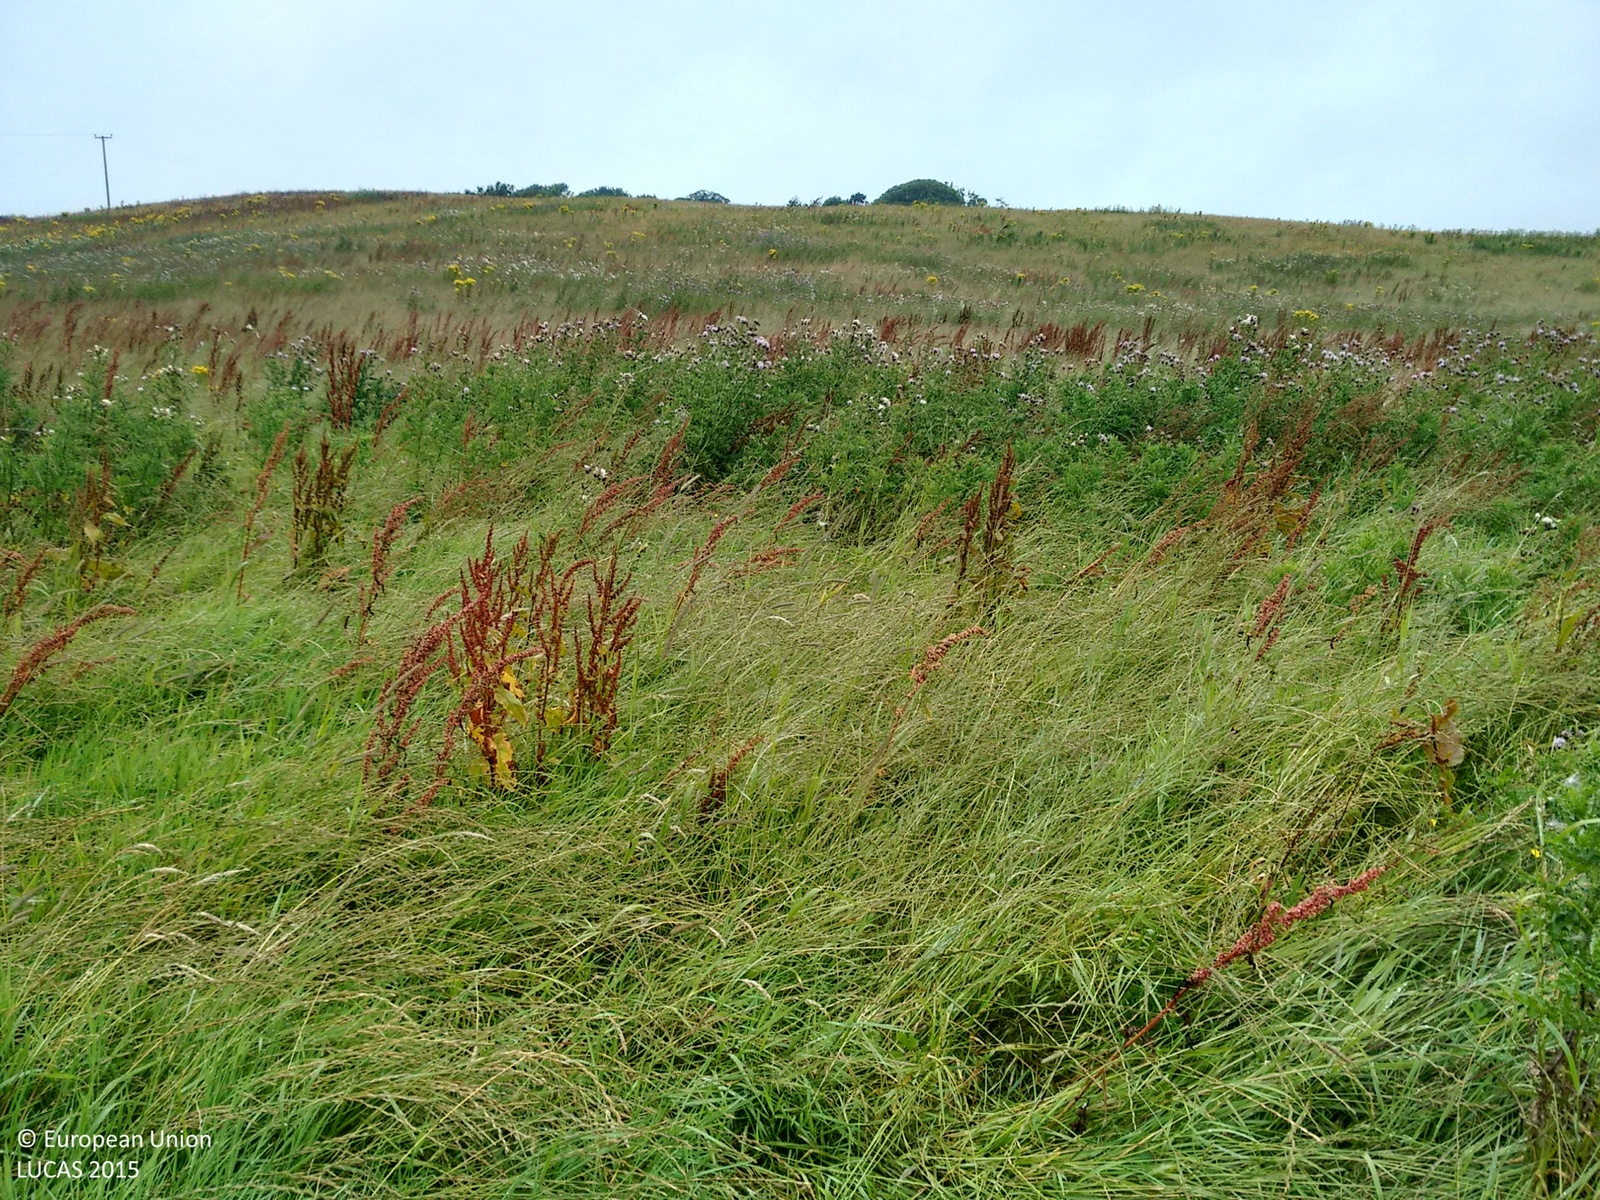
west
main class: Grassland
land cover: Grassland without tree/shrub cover
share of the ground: > 75 %
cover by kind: herbaceous plants 100 %
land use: Agriculture (excluding fallow land and kitchen gardens)
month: August
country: GB
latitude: 54.3046
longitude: -5.7642
